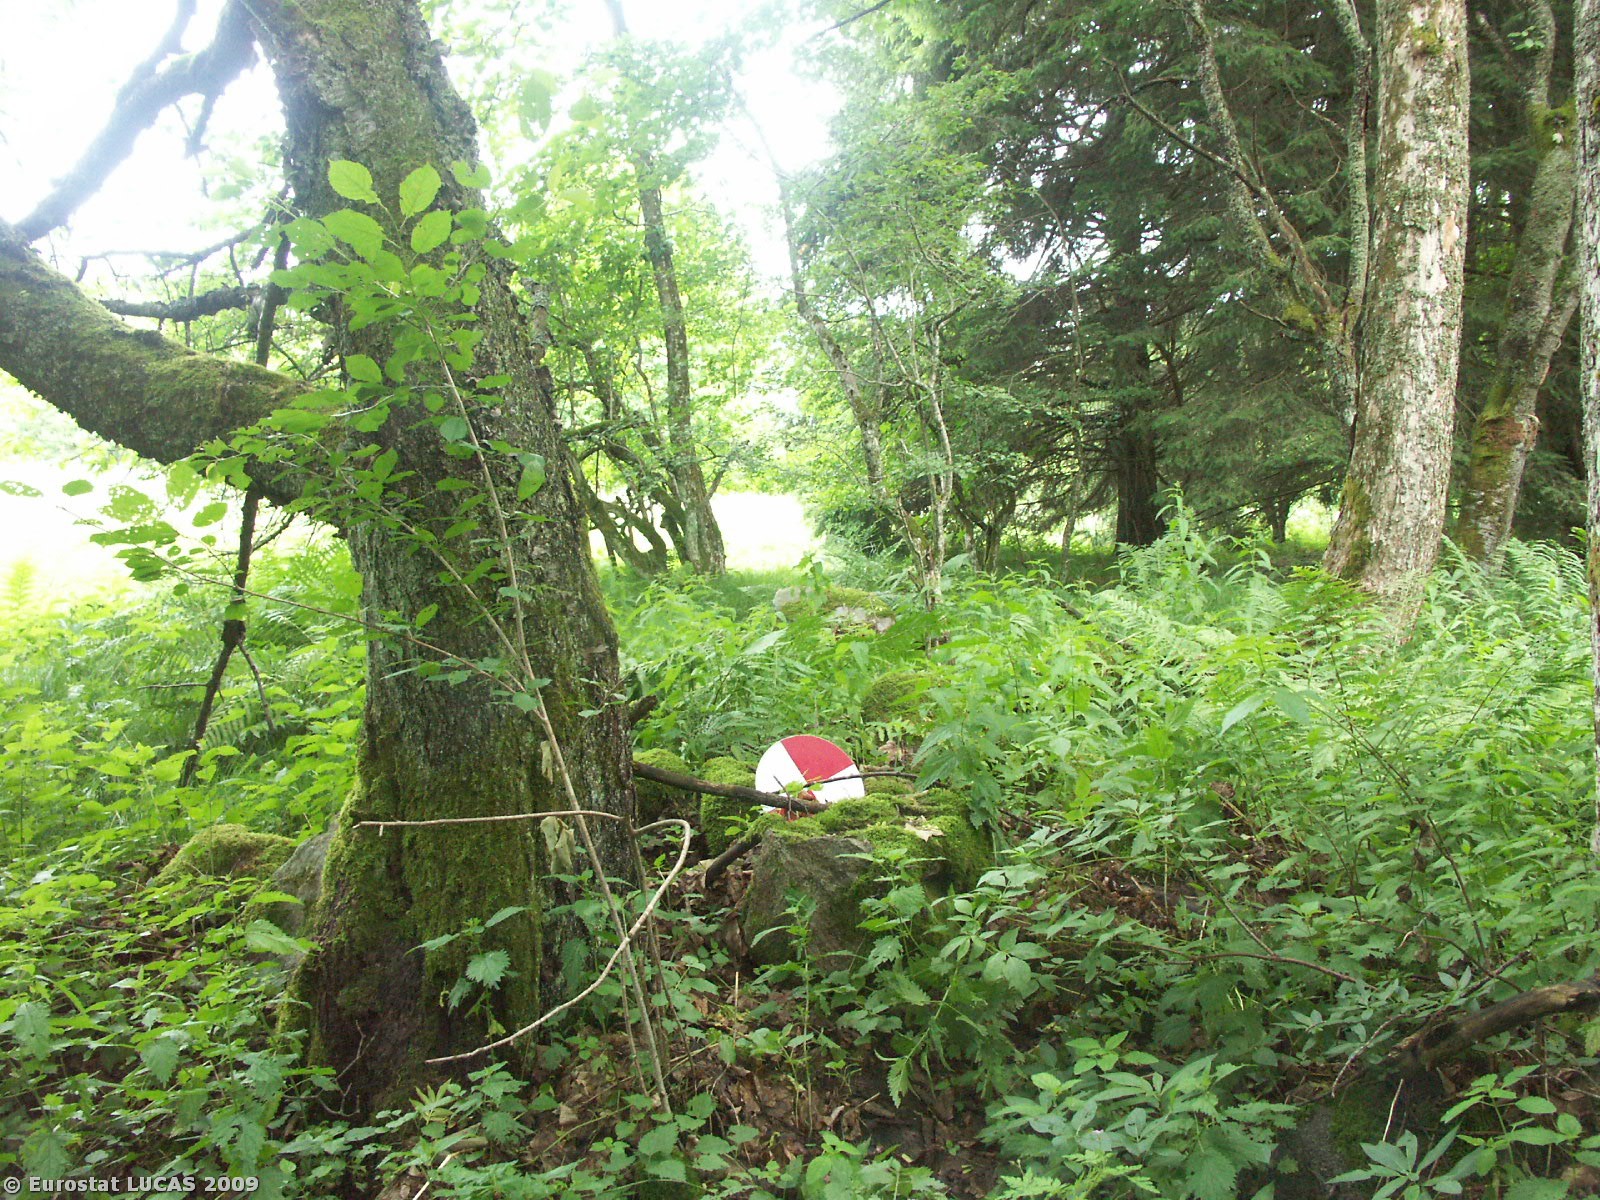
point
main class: Woodland
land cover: Broadleaved woodland
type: mesophytic deciduous forest
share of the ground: > 75 %
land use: Nature reserves
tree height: > 5 m
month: June
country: CZ
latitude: 48.6164
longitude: 14.0832
